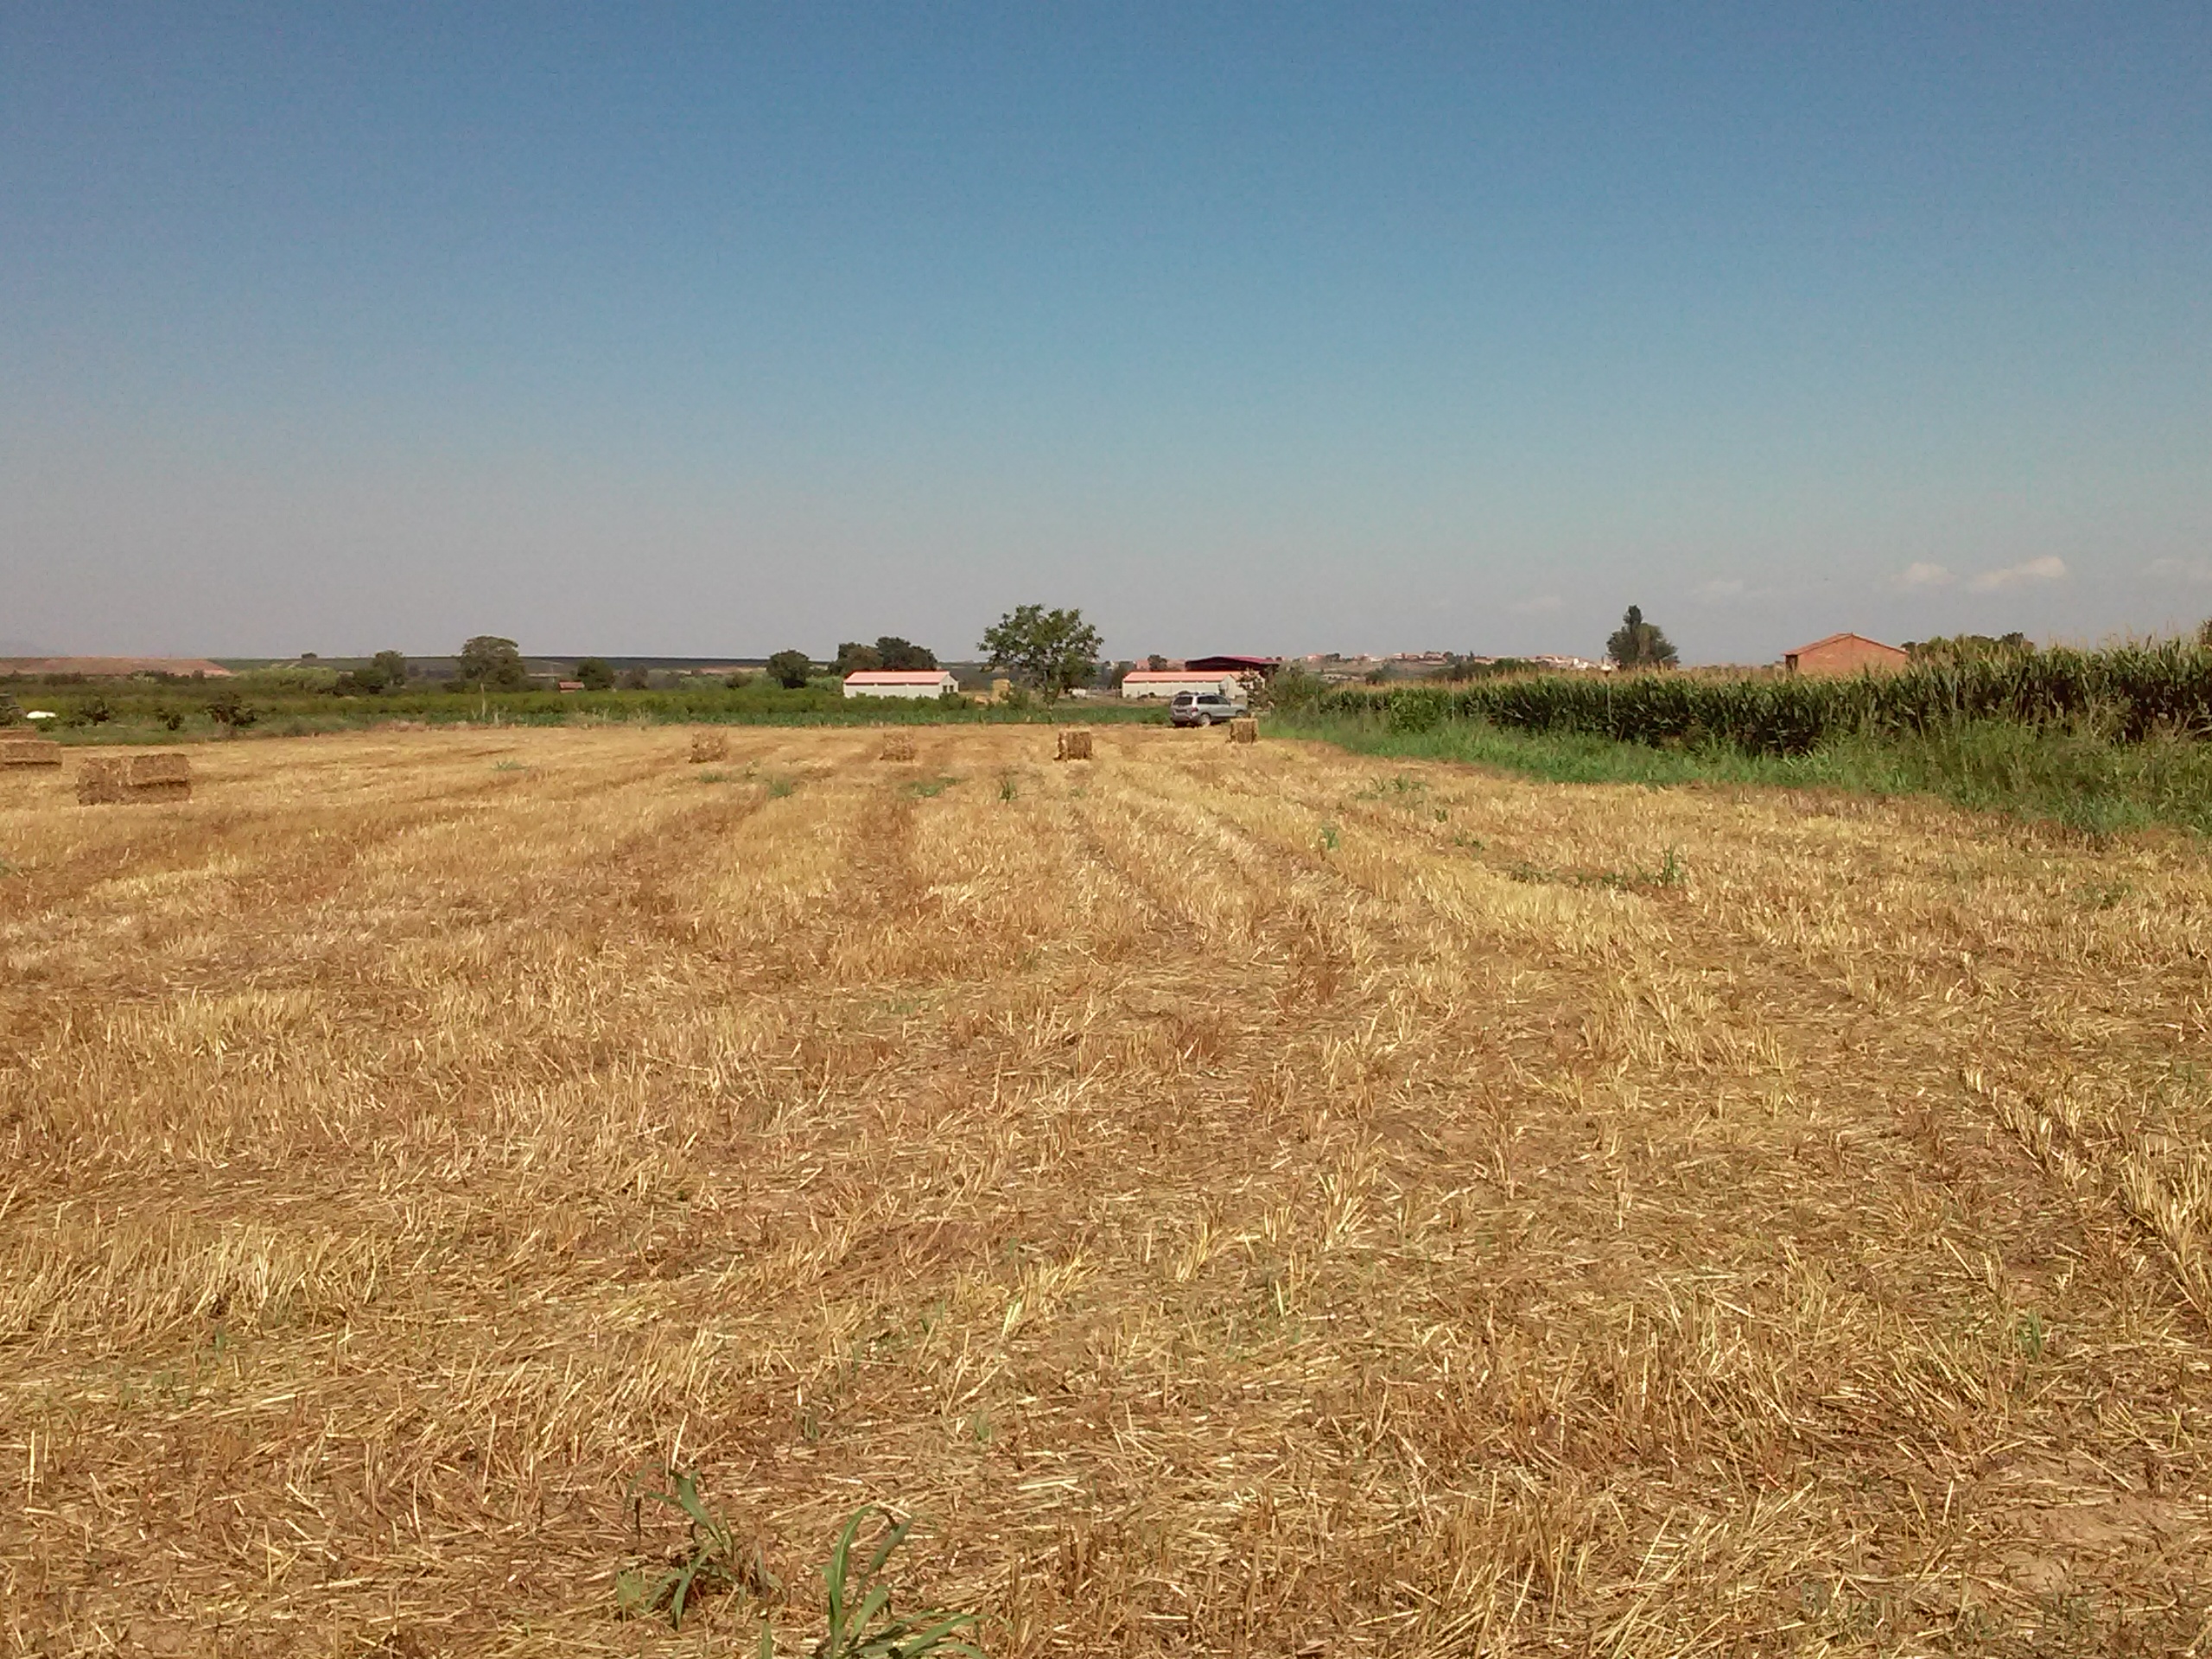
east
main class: Cropland
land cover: Common wheat
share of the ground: < 10 %
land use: Agriculture (excluding fallow land and kitchen gardens)
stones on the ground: 10 - 25 %
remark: Harvested field
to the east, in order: Common wheat; Grass margins; Tracks; Grass margins; Other bare soil; Groves; Other bare soil; Grass margins; Lucerne
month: July
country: ES
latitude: 41.7430
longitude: 0.5954
